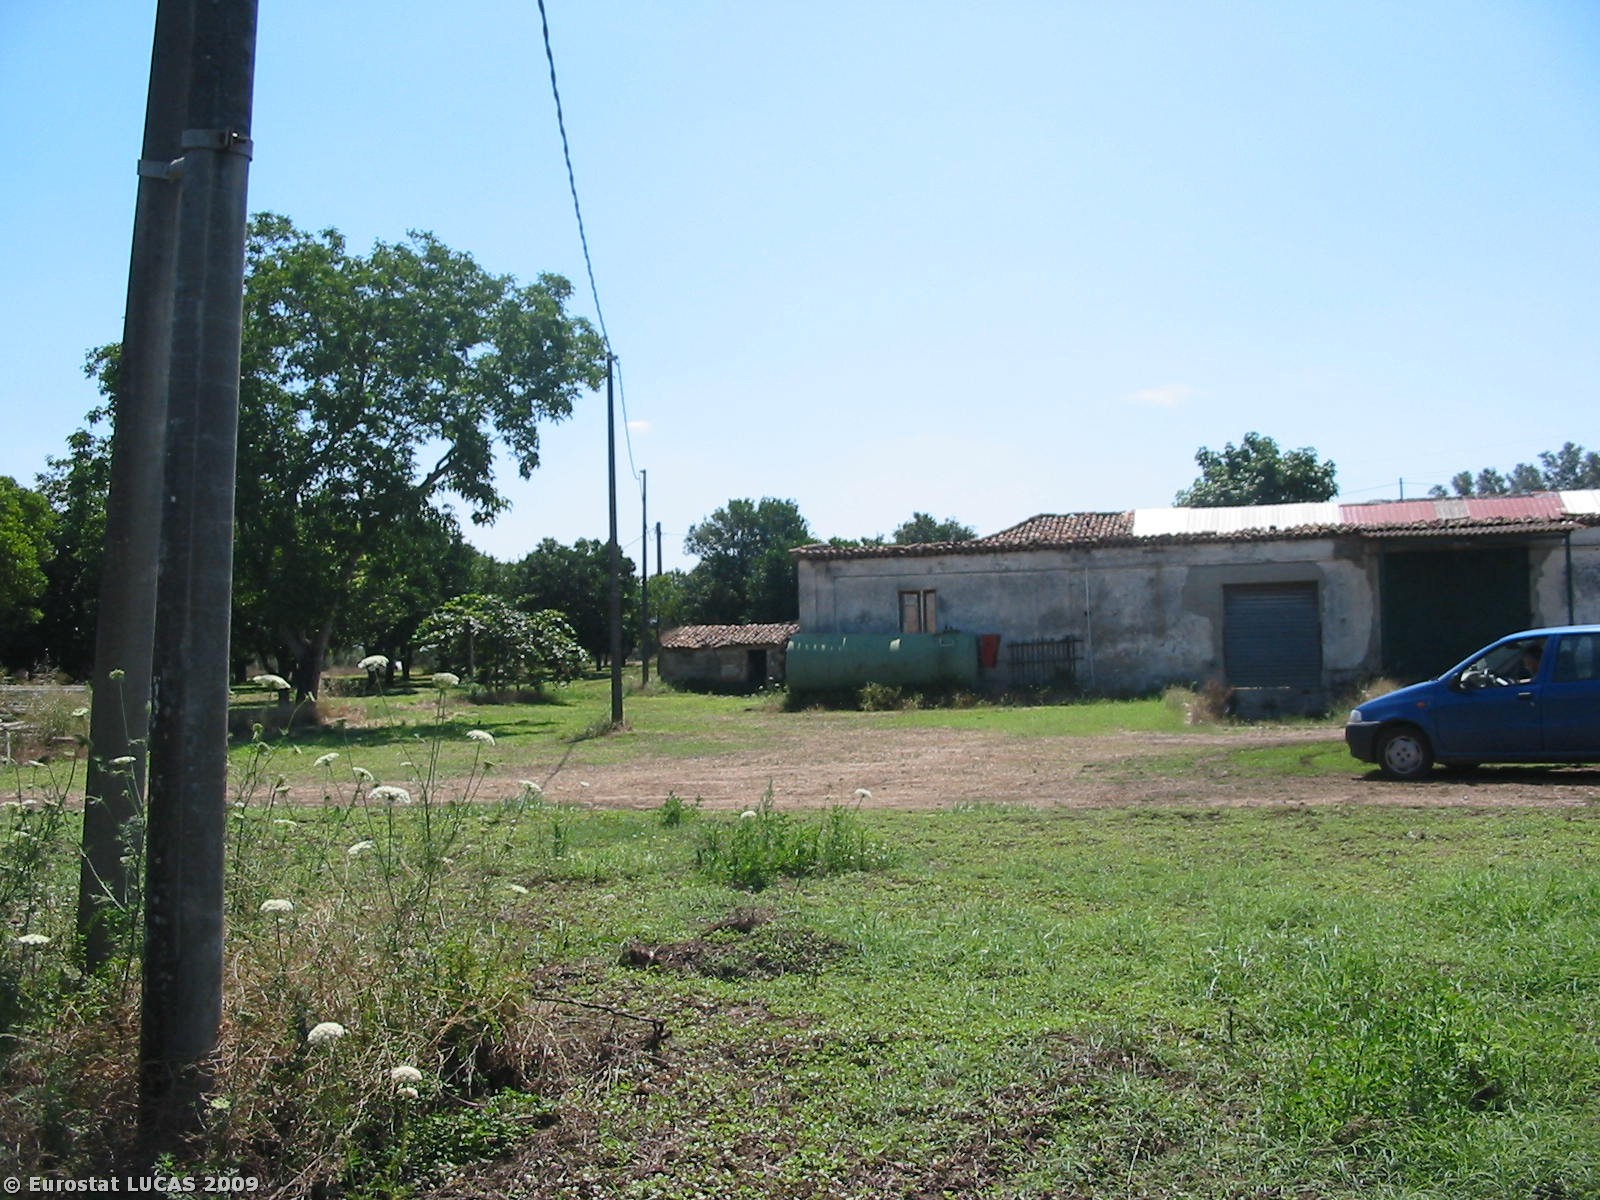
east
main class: Cropland
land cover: Oranges
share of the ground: > 75 %
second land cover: Spontaneously vegetated surfaces
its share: 50 - 75 %
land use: Agriculture (excluding fallow land and kitchen gardens)
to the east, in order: Oranges; Spontaneously vegetated surfaces; Artificial constructions in urban areas; Oranges; Spontaneously vegetated surfaces; Electric lines; Olive groves; Spontaneously vegetated surfaces
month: July
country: IT
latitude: 38.4170
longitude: 15.9321
